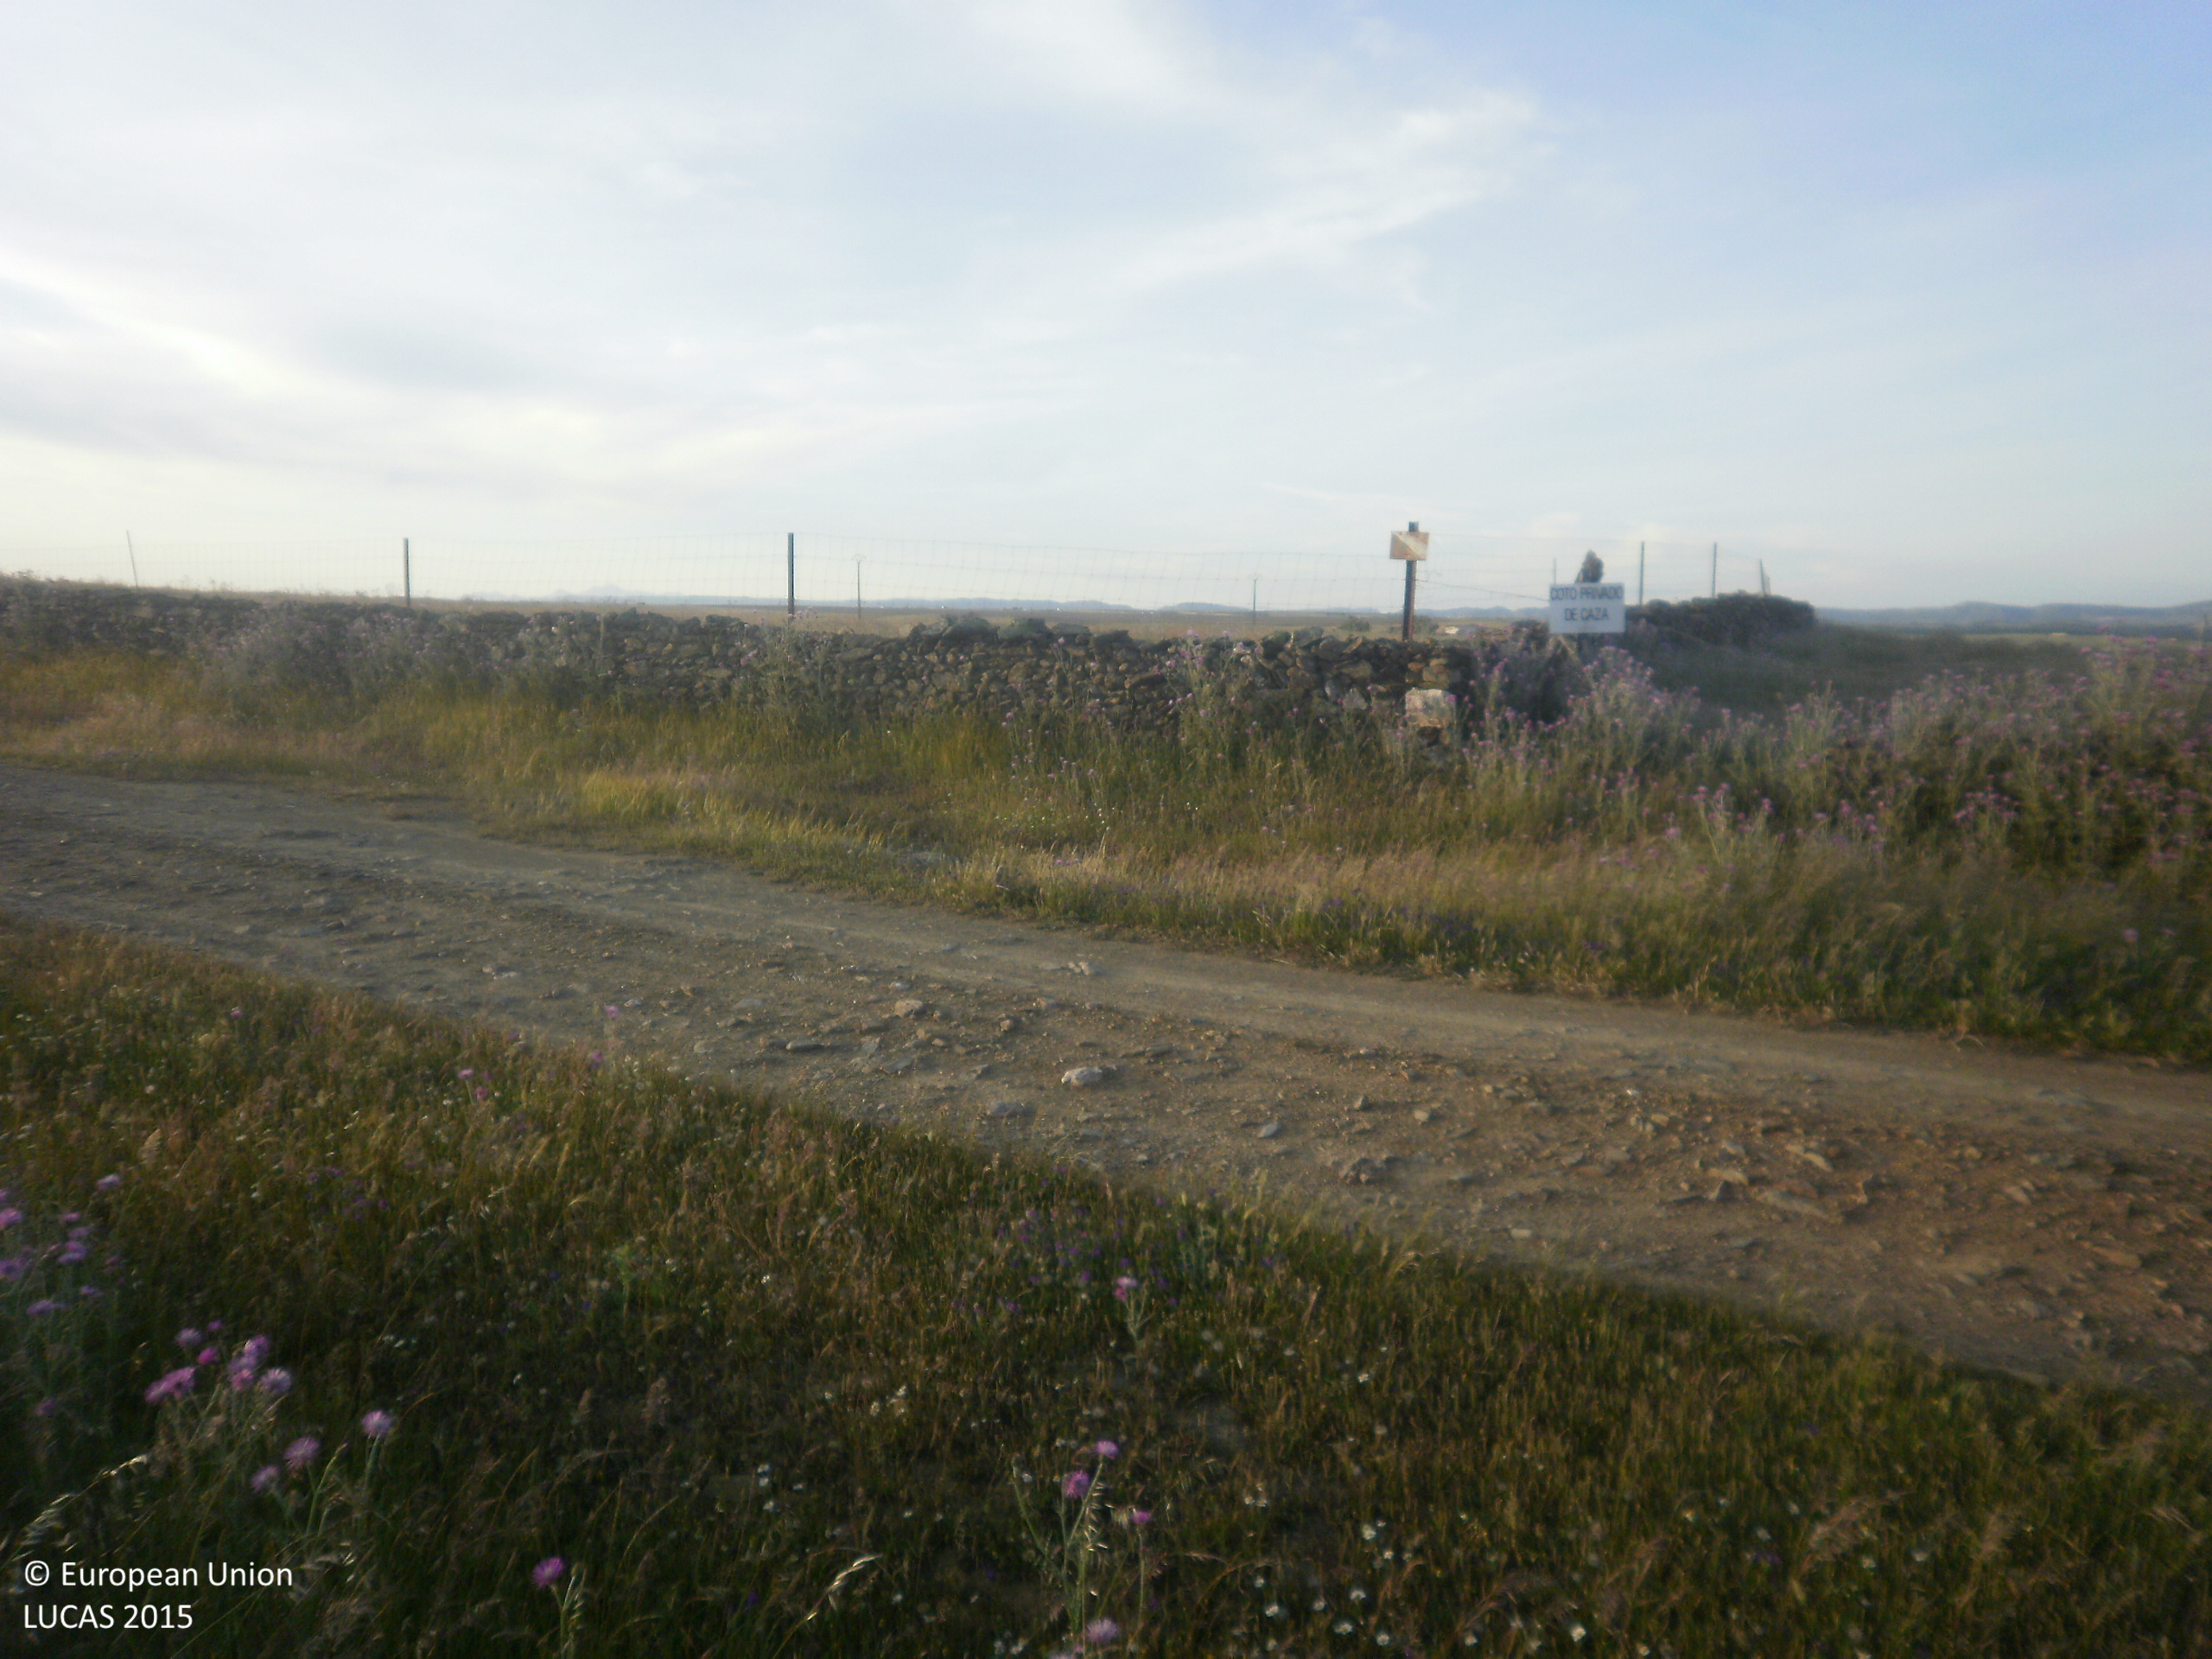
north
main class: Grassland
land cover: Grassland without tree/shrub cover
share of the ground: > 75 %
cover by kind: herbaceous plants 100 %
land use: Agriculture (excluding fallow land and kitchen gardens)
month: April
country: ES
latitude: 38.9804
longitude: -5.2185
